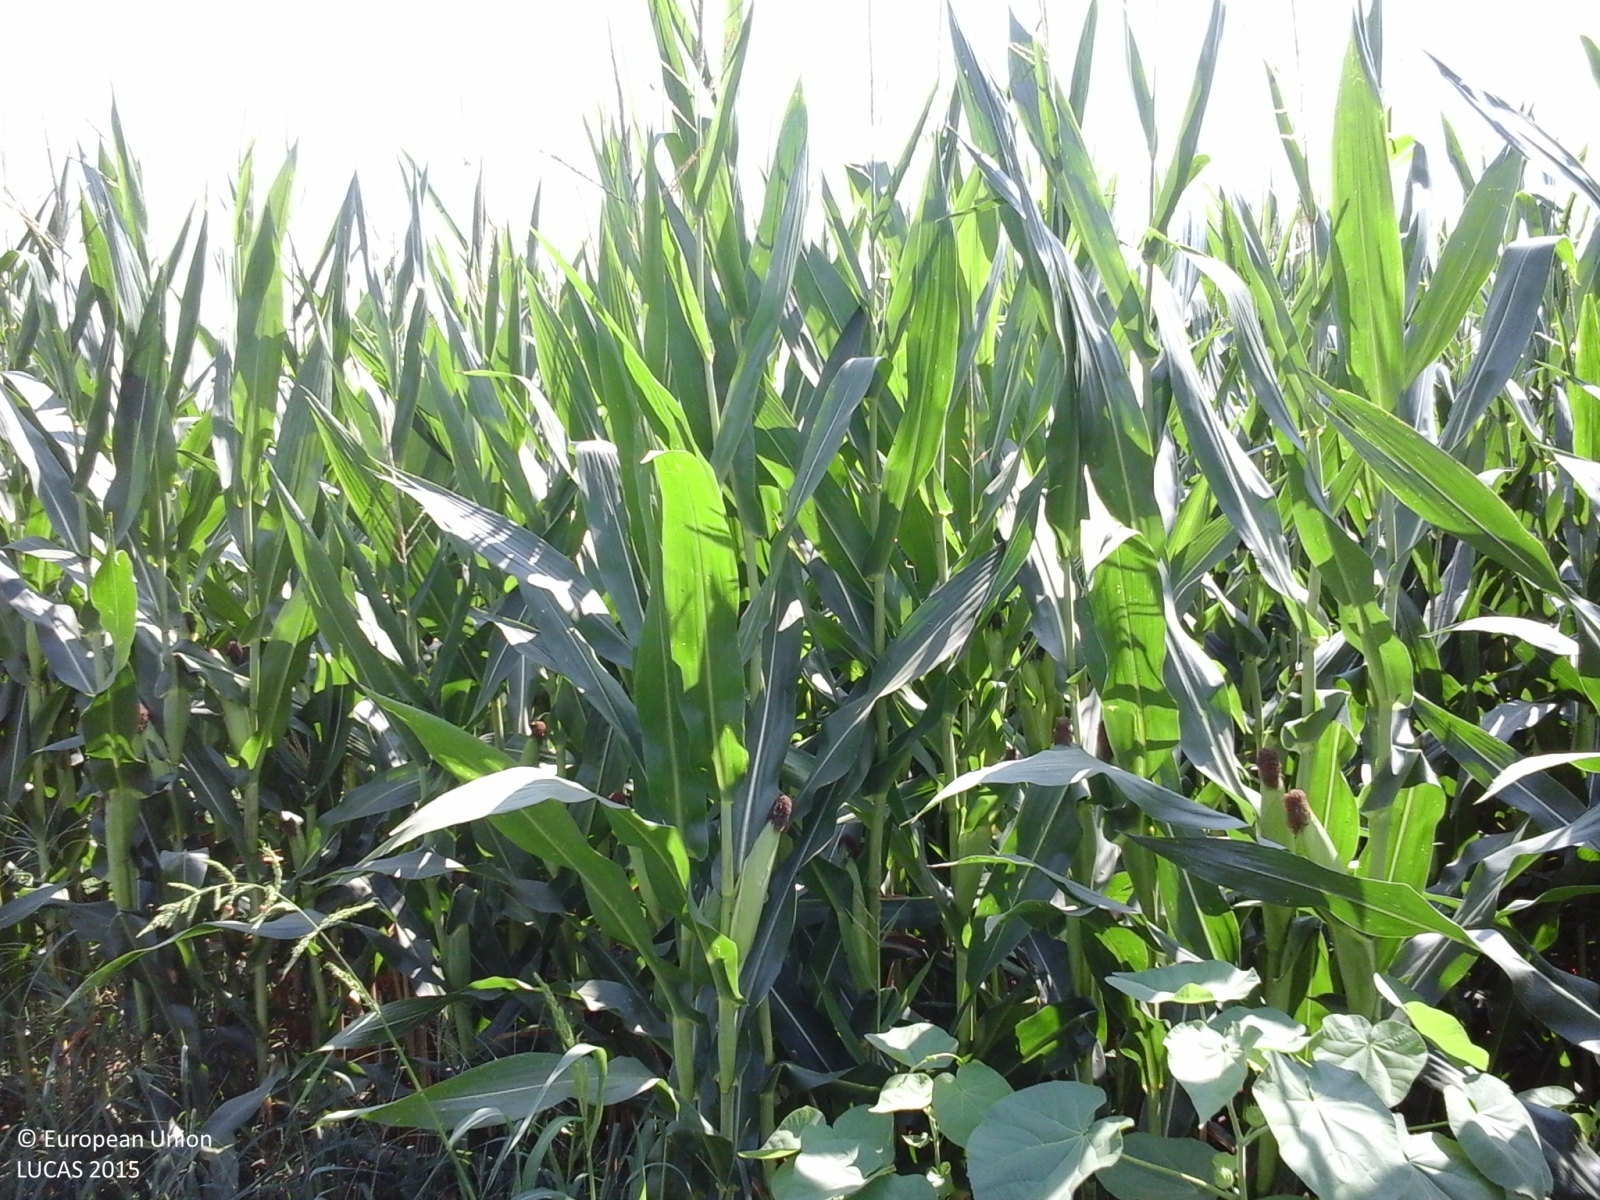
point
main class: Cropland
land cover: Maize
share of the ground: > 75 %
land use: Agriculture (excluding fallow land and kitchen gardens)
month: July
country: IT
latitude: 44.3963
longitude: 7.6572
